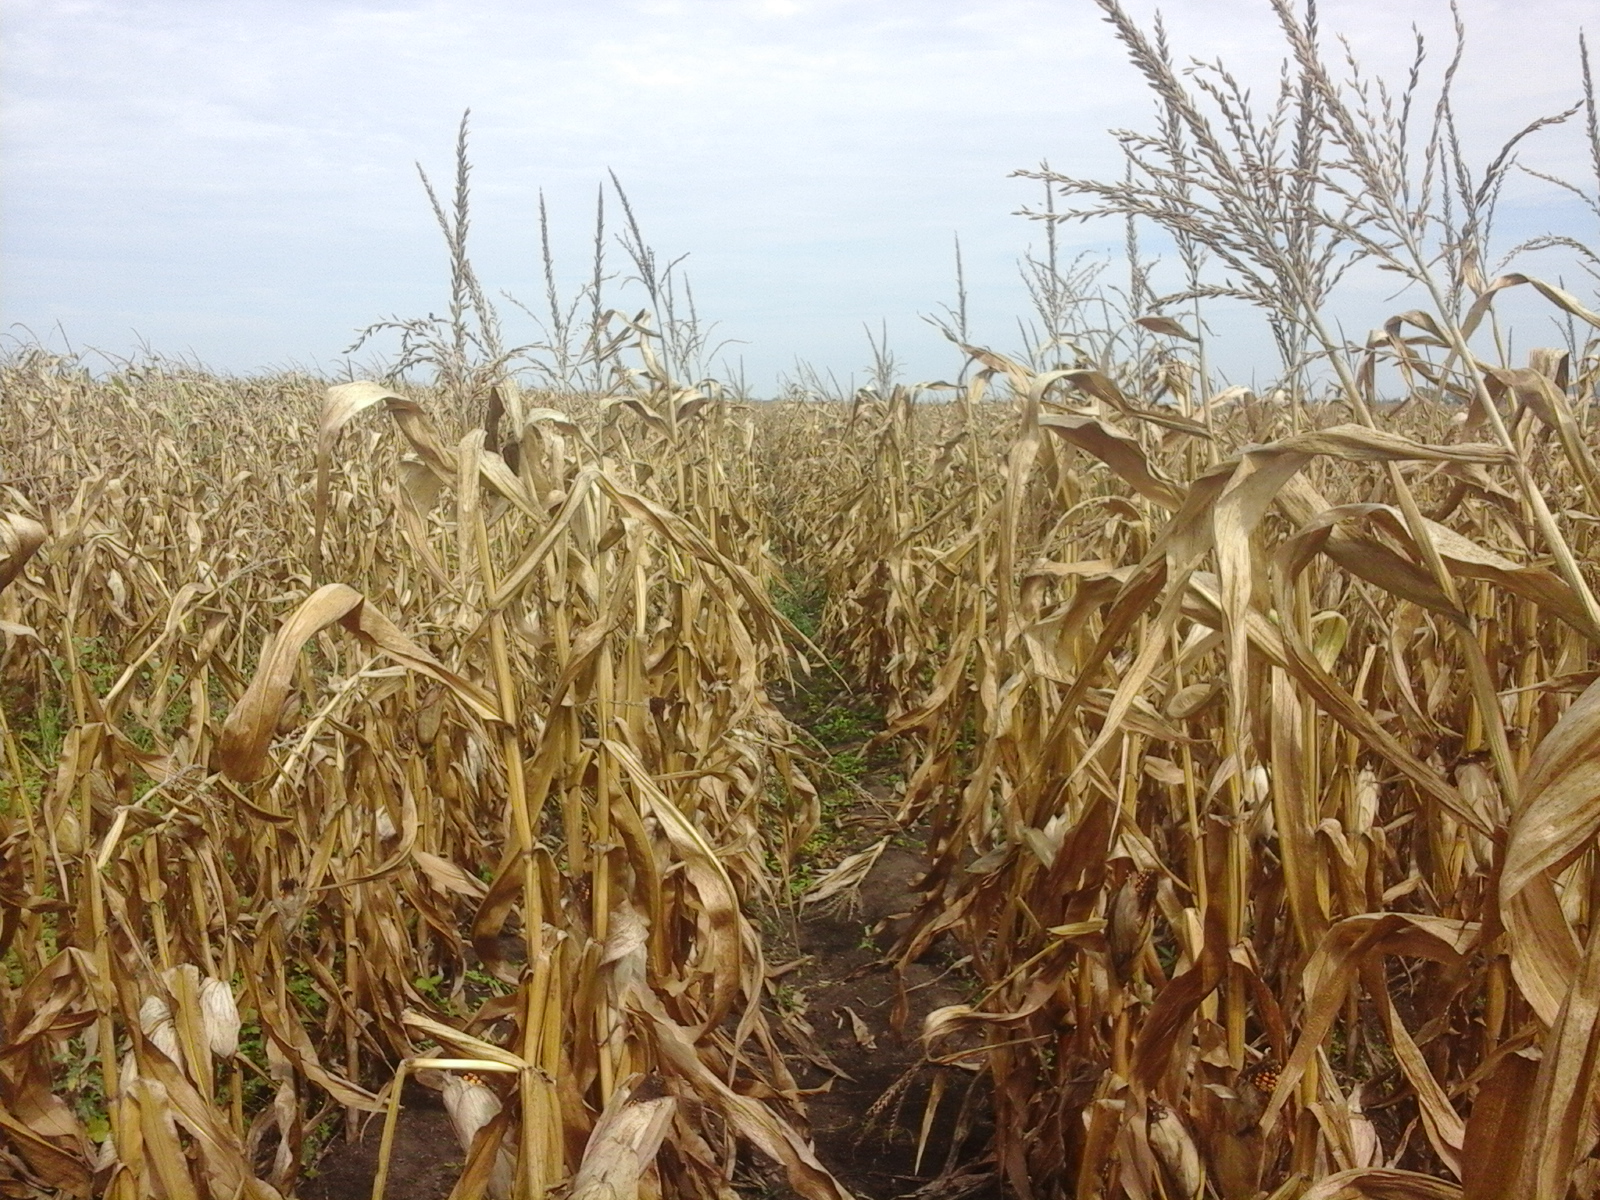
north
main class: Cropland
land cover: Maize
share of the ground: > 75 %
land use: Agriculture (excluding fallow land and kitchen gardens)
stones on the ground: < 10 %
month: August
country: RO
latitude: 46.3113
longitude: 21.6608
